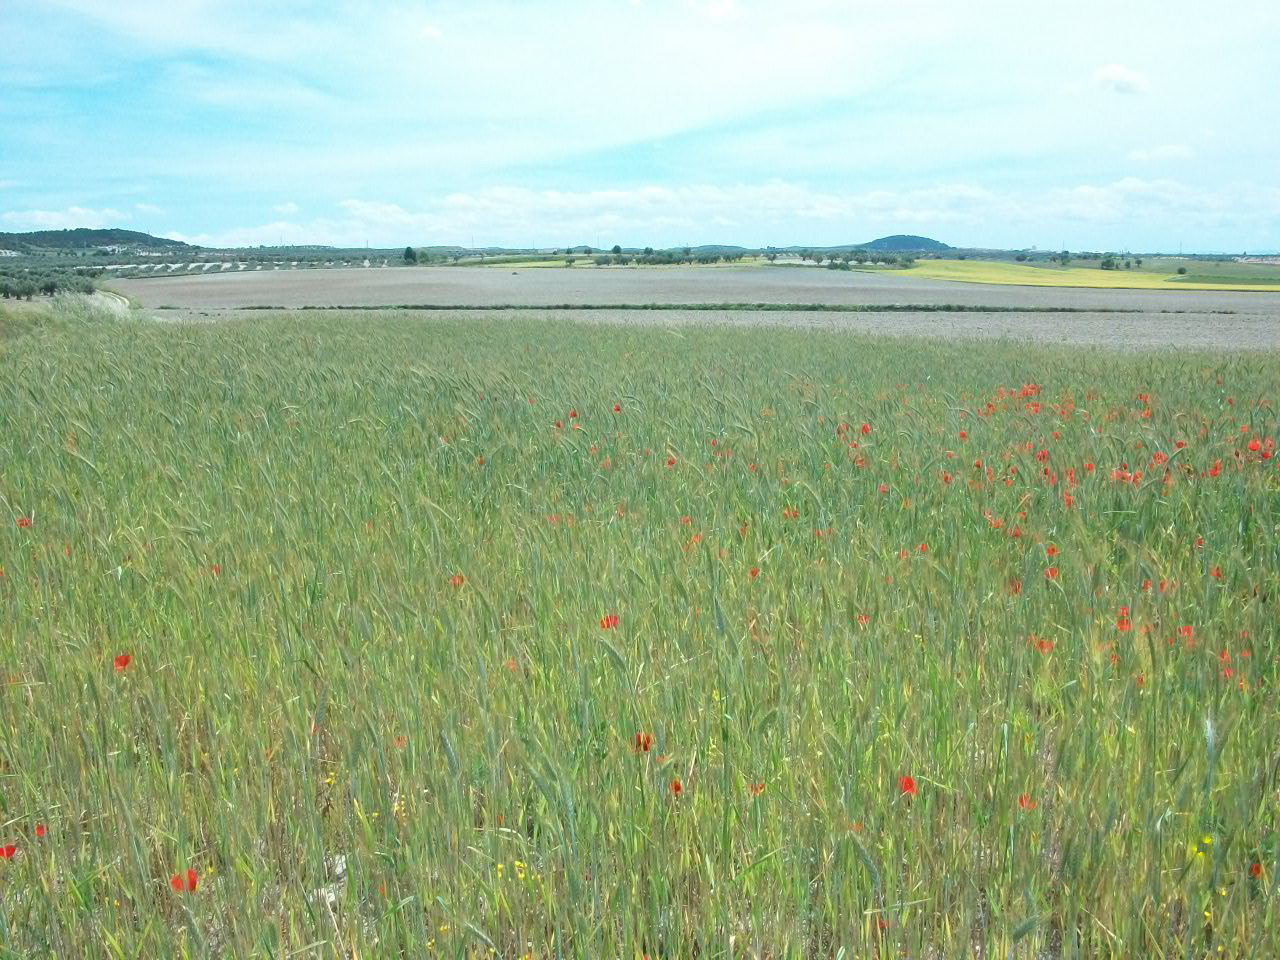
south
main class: Cropland
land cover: Mixed cereals for fodder
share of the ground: > 75 %
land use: Agriculture (excluding fallow land and kitchen gardens)
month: May
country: ES
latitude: 40.1541
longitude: -3.7585
